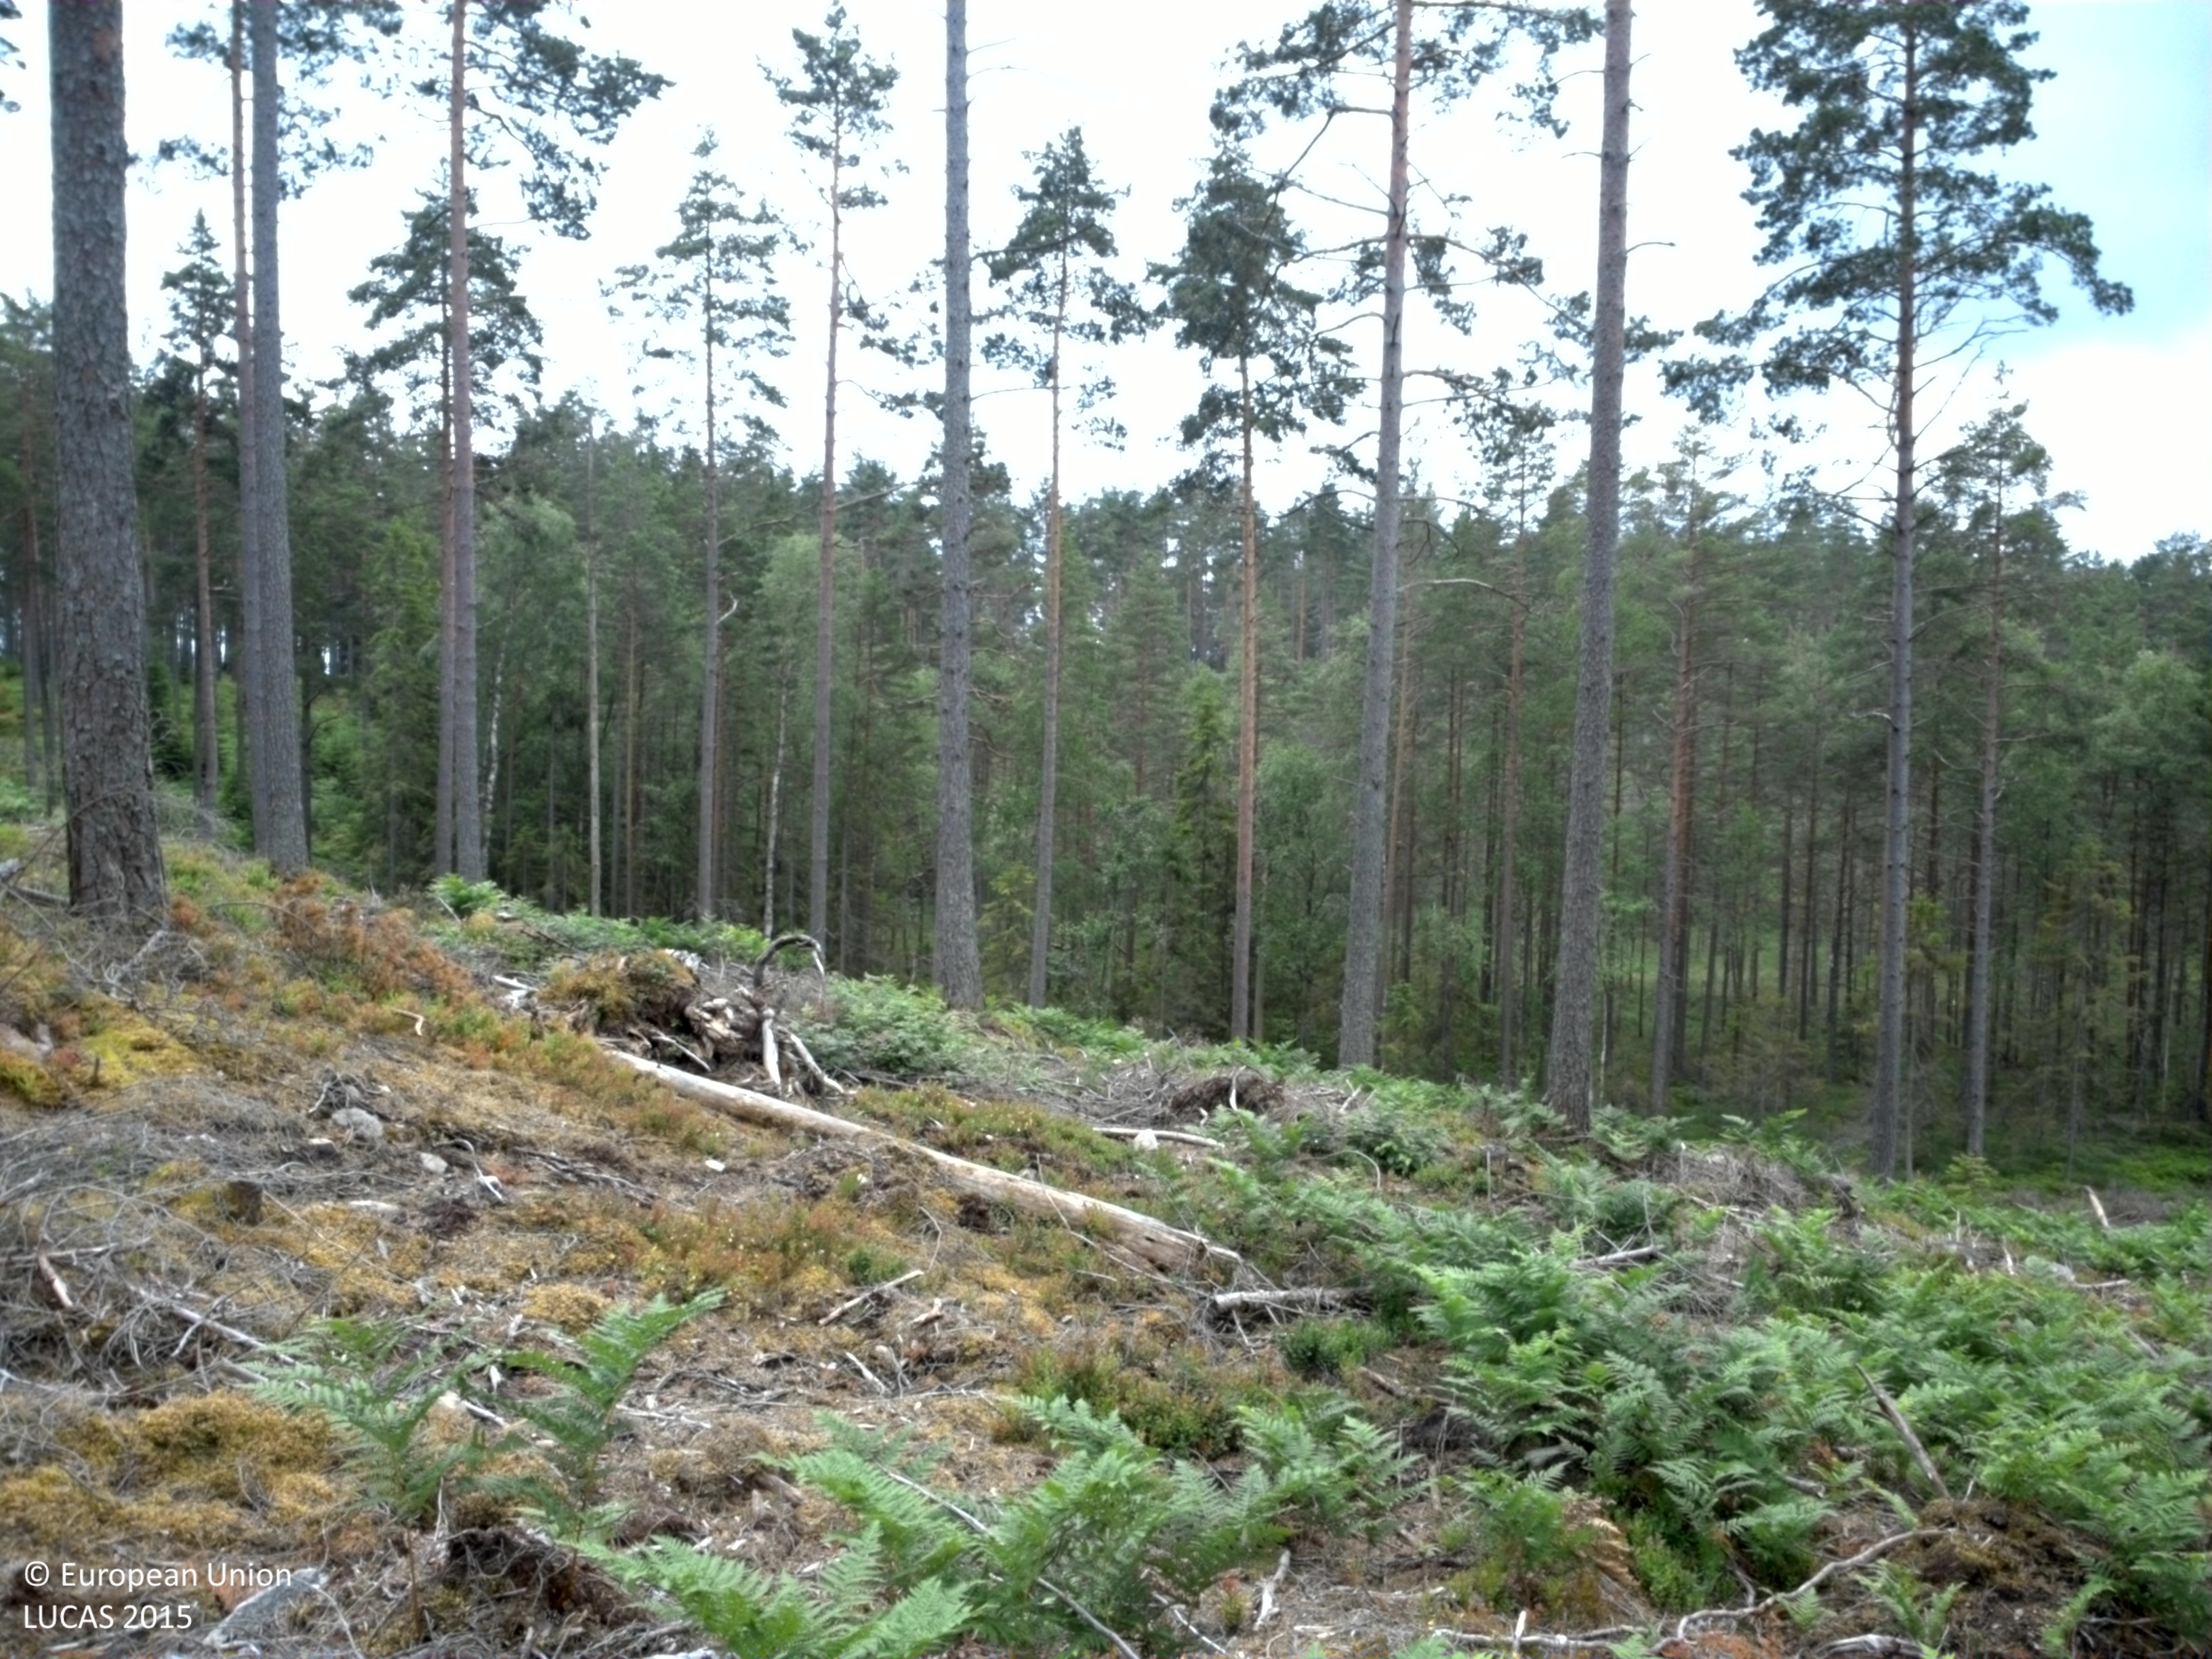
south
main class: Woodland
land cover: Pine dominated coniferous woodland
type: boreal forest
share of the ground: 10 - 25 %
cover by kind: shrubs 60 %, unconsolidated bare surface 25 %, coniferous forest trees 15 %
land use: Forestry
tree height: > 5 m
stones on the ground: > 50 %
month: July
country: SE
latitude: 58.8330
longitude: 14.3756
